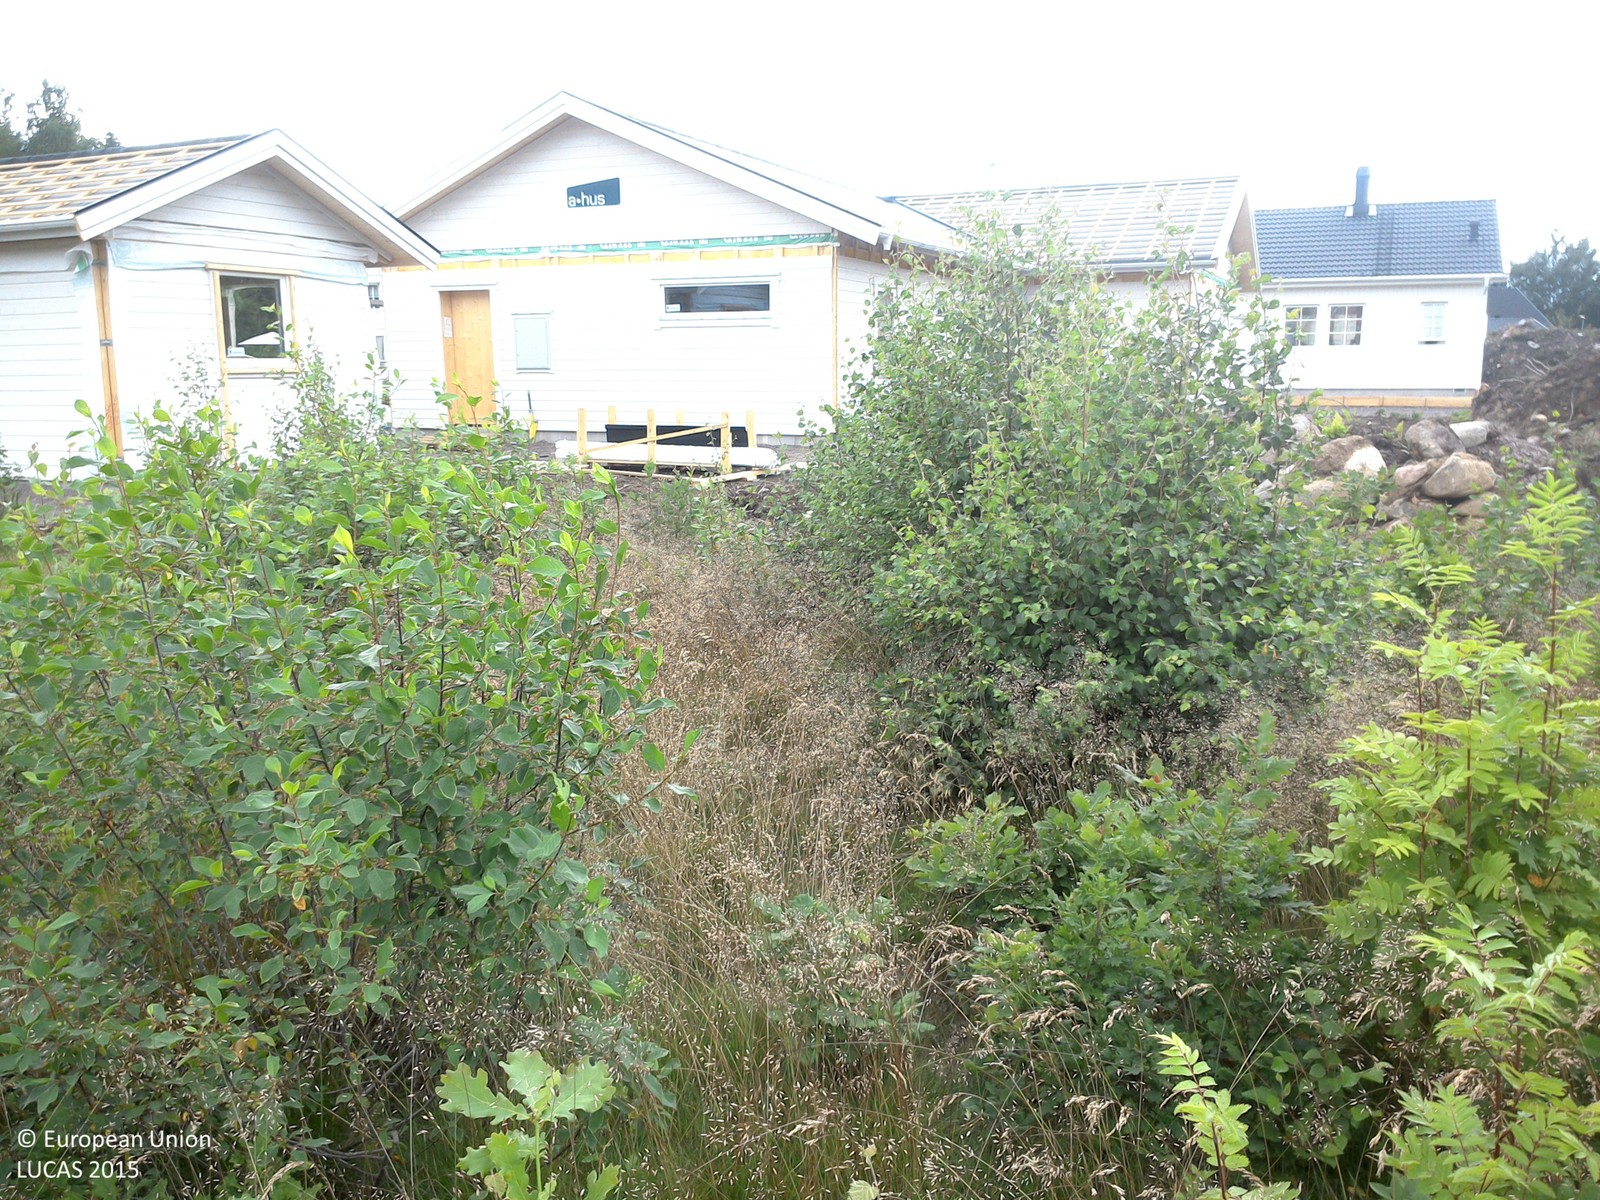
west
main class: Grassland
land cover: Grassland with sparse tree/shrub cover
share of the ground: > 75 %
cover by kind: herbaceous plants 90 %, broadleaved forest trees 5 %, shrubs 5 %
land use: Residential
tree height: > 5 m
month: July
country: SE
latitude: 58.5581
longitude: 15.0295
